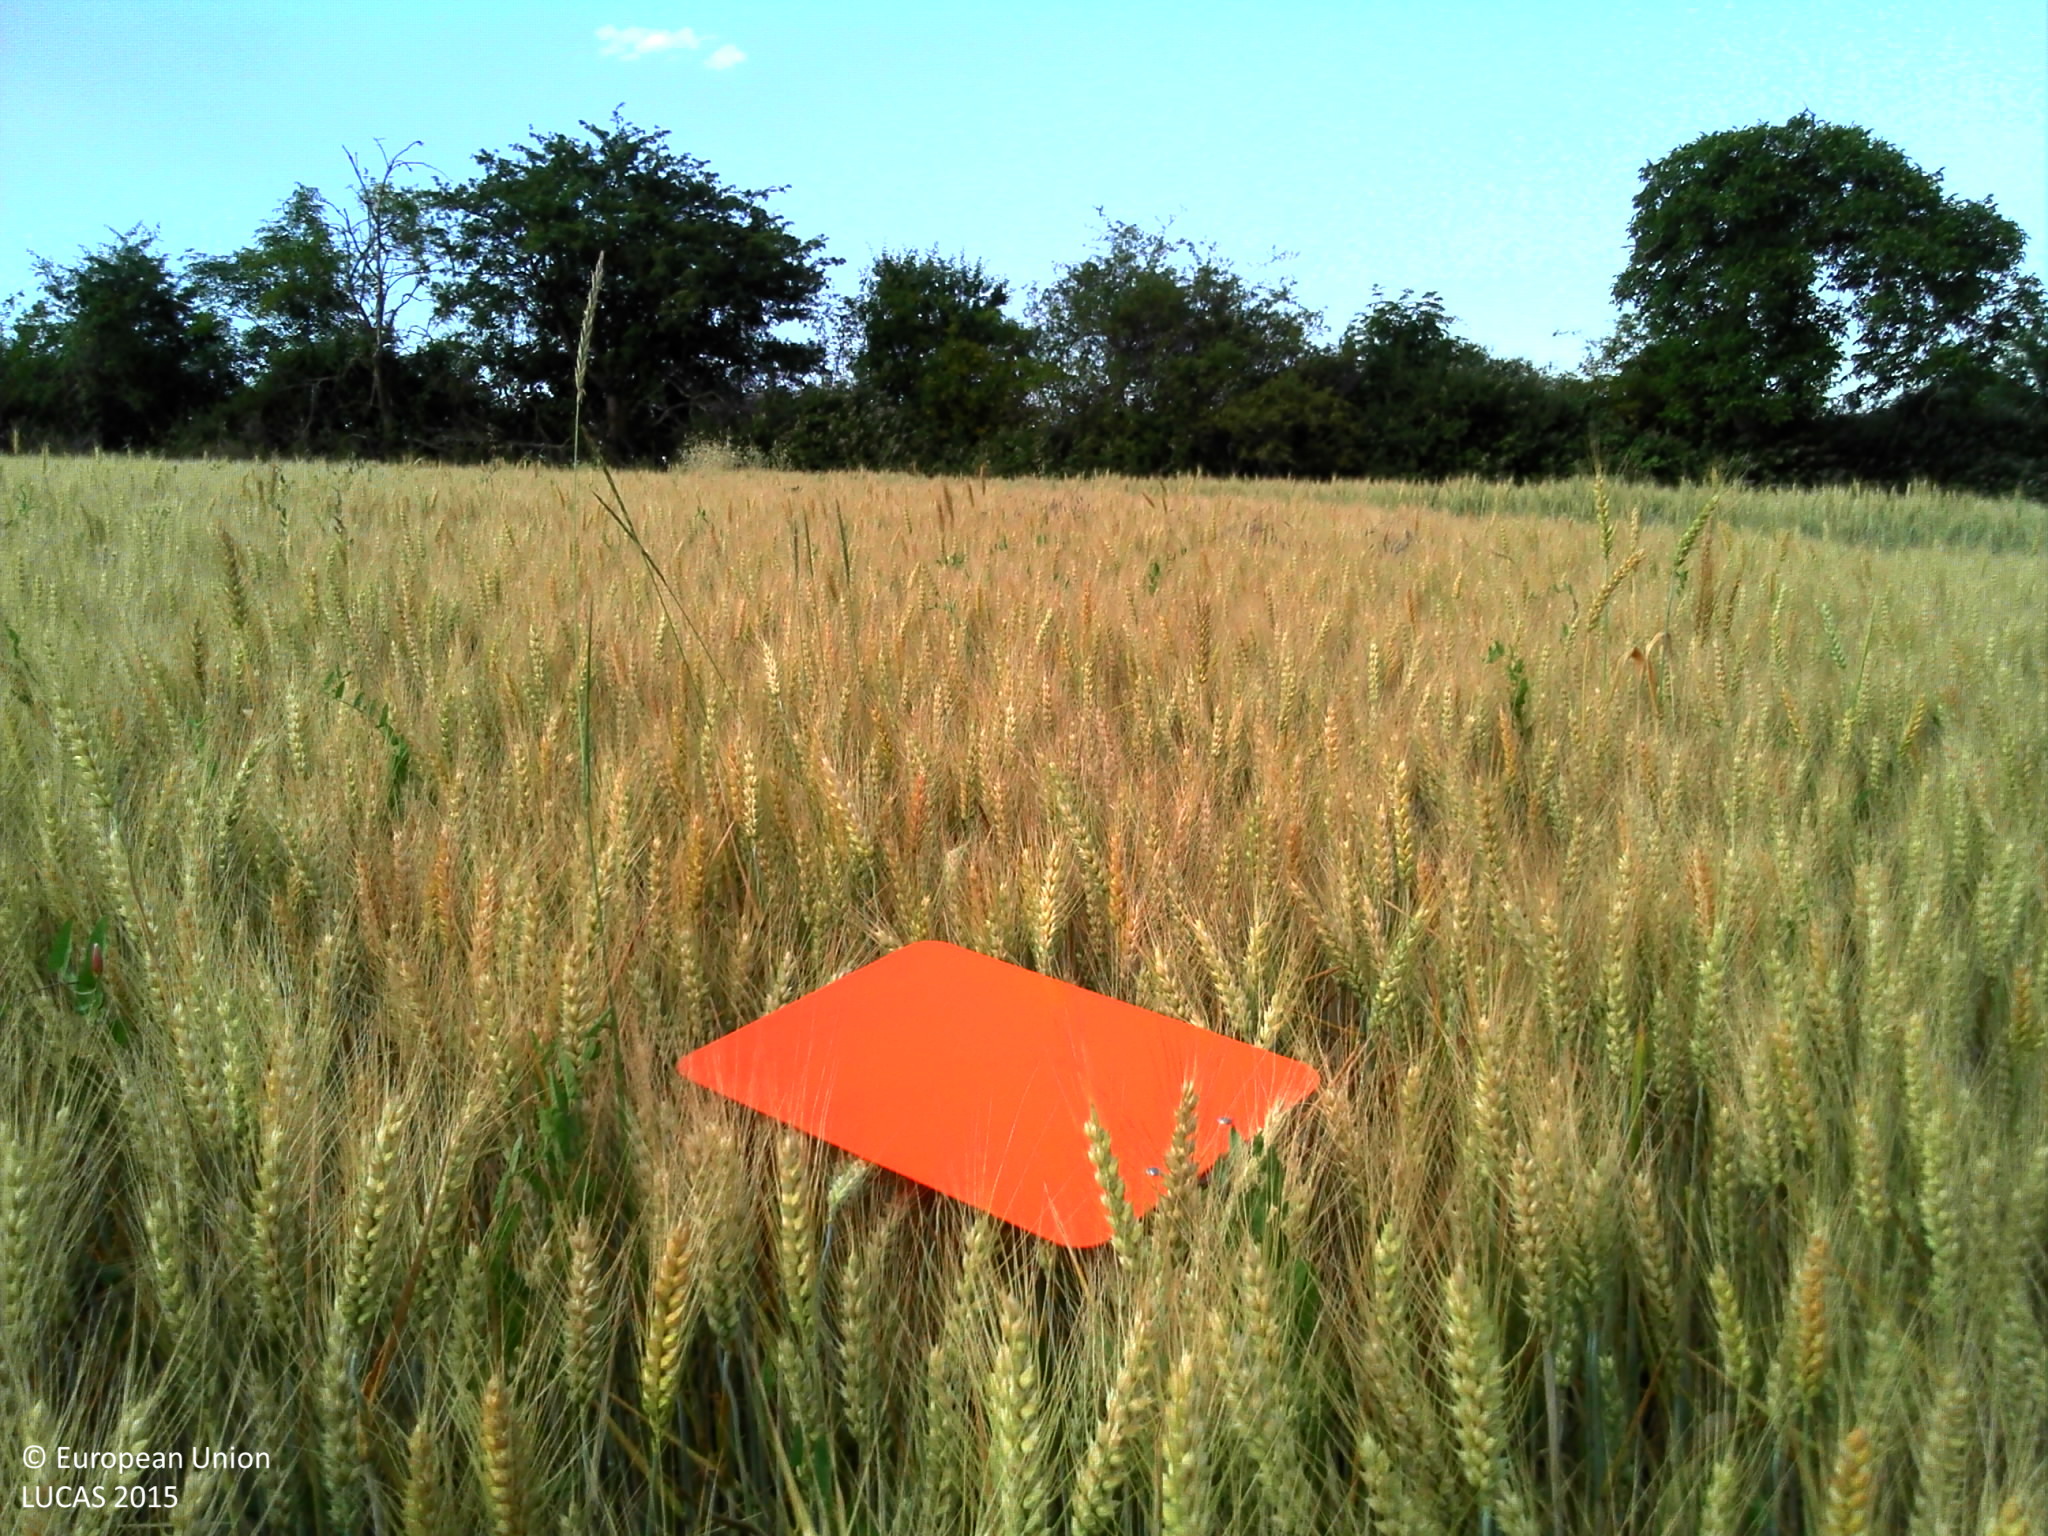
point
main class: Cropland
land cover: Common wheat
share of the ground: > 75 %
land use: Agriculture (excluding fallow land and kitchen gardens)
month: June
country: FR
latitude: 45.4974
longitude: 3.1287
